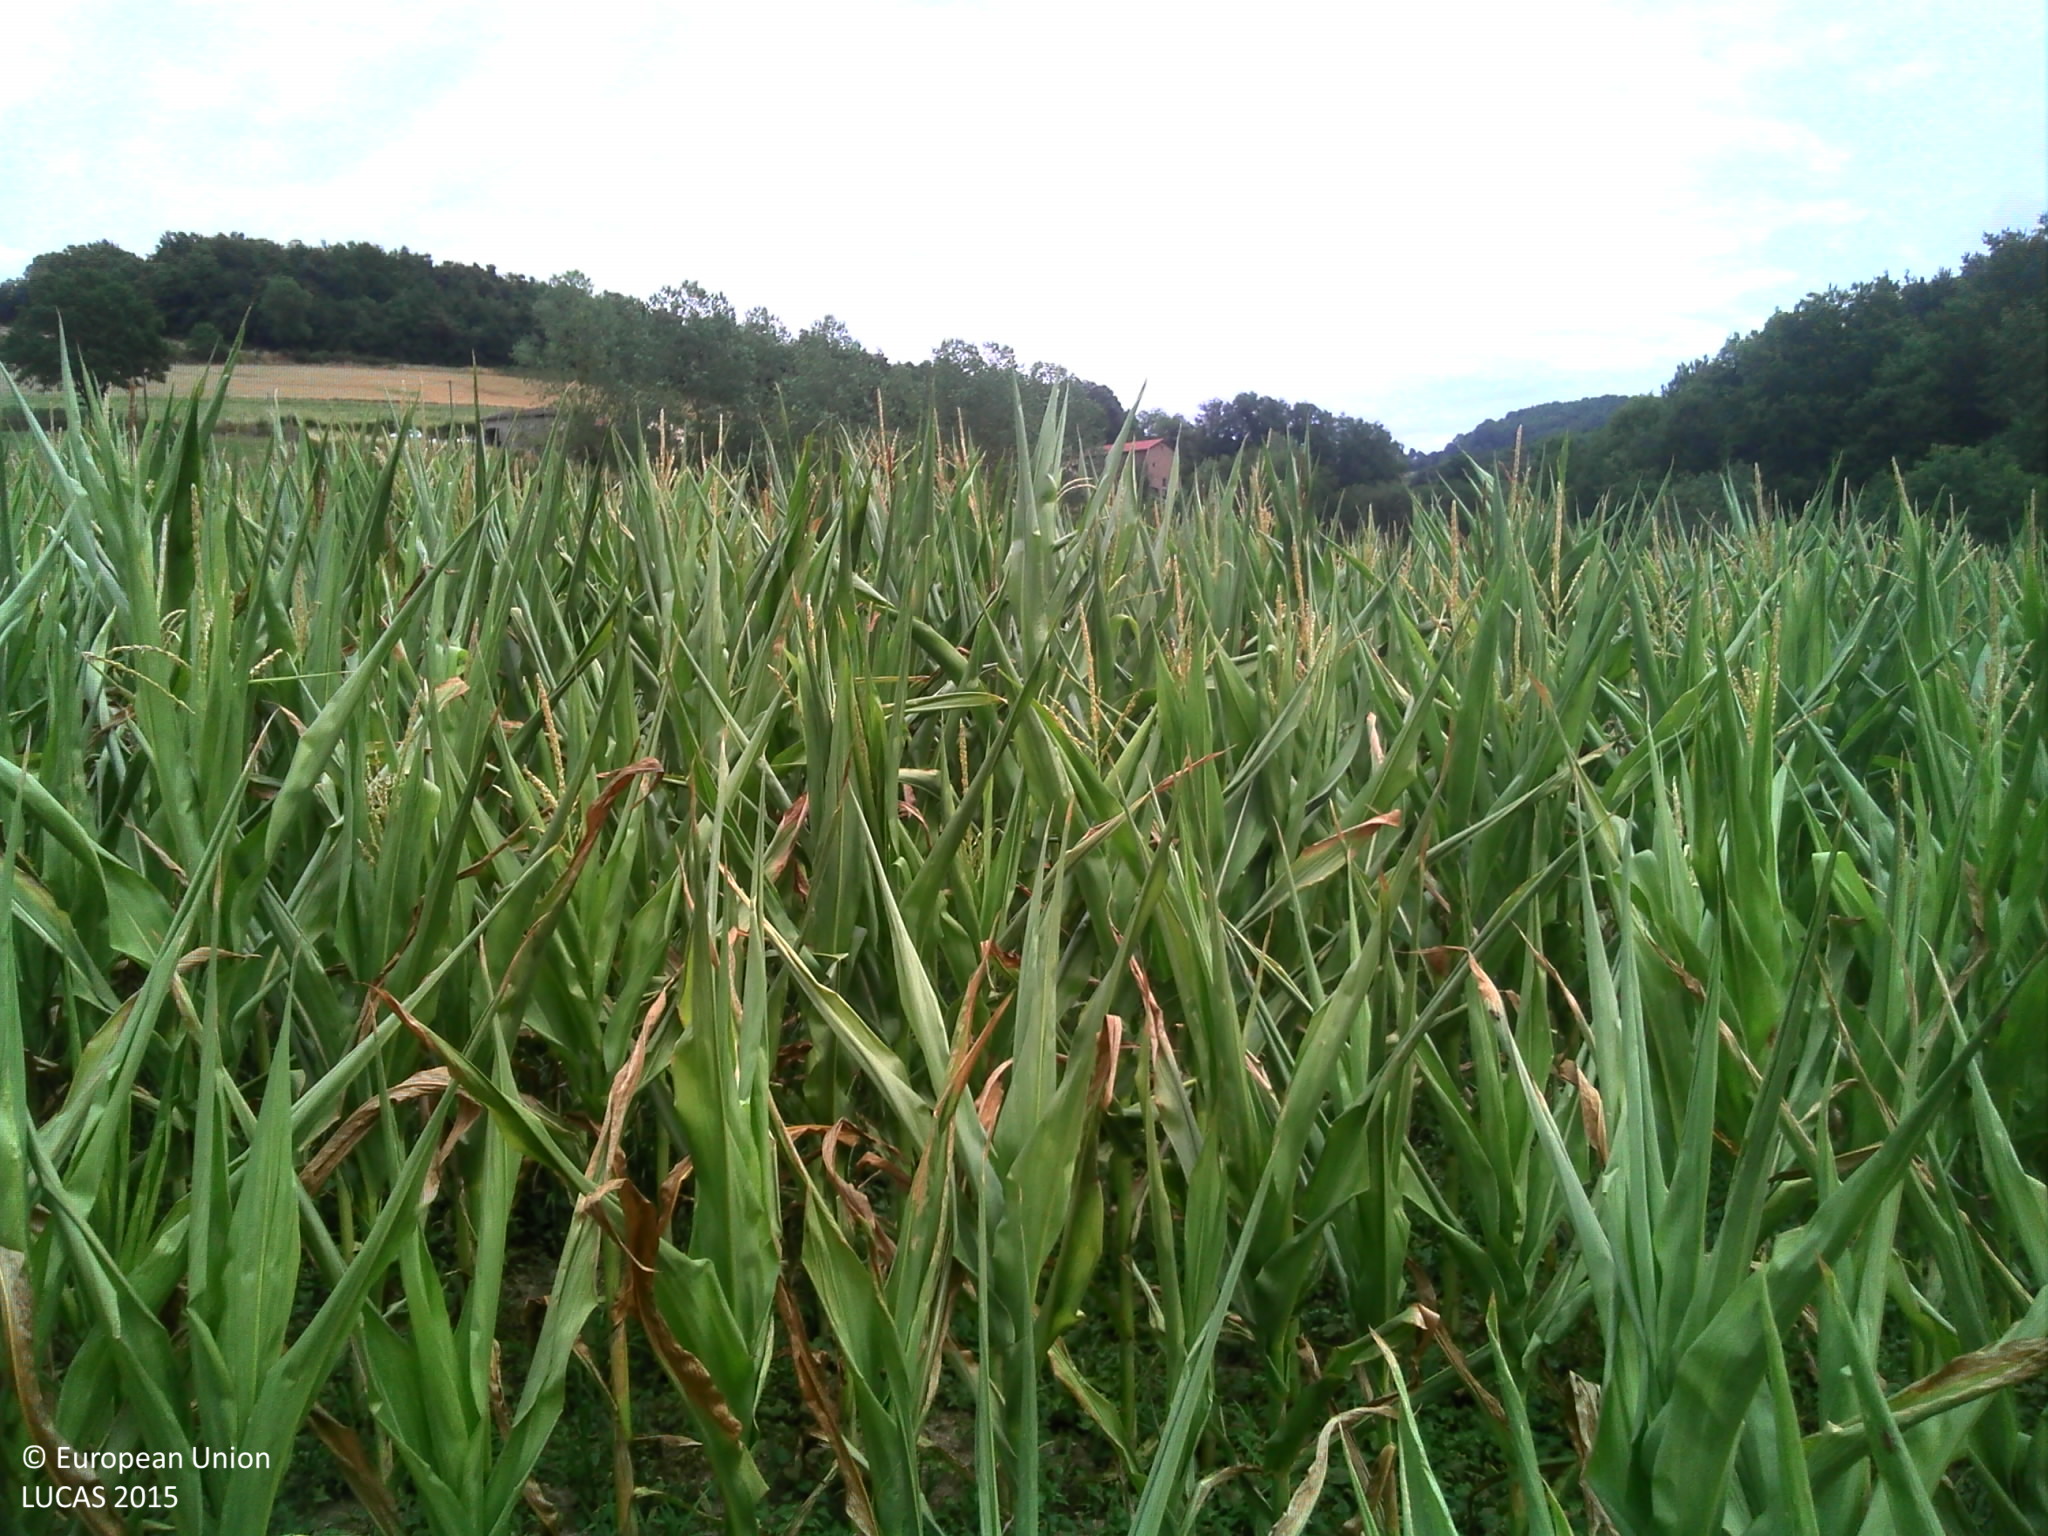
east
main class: Cropland
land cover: Maize
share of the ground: > 75 %
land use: Agriculture (excluding fallow land and kitchen gardens)
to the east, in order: Maize; Fences; Grassland without tree/shrub cover; Fences; Spontaneously vegetated surfaces; Inland fresh water bodies; Spontaneously vegetated surfaces; Grassland with sparse tree/shrub cover; Fences; Broadleaved woodland; Grassland with sparse tree/shrub cover; Fences; Grassland with sparse tree/shrub cover; Fences; Grassland without tree/shrub cover; Fences; Grassland with sparse tree/shrub cover
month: July
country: FR
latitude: 45.5947
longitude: 4.4785
